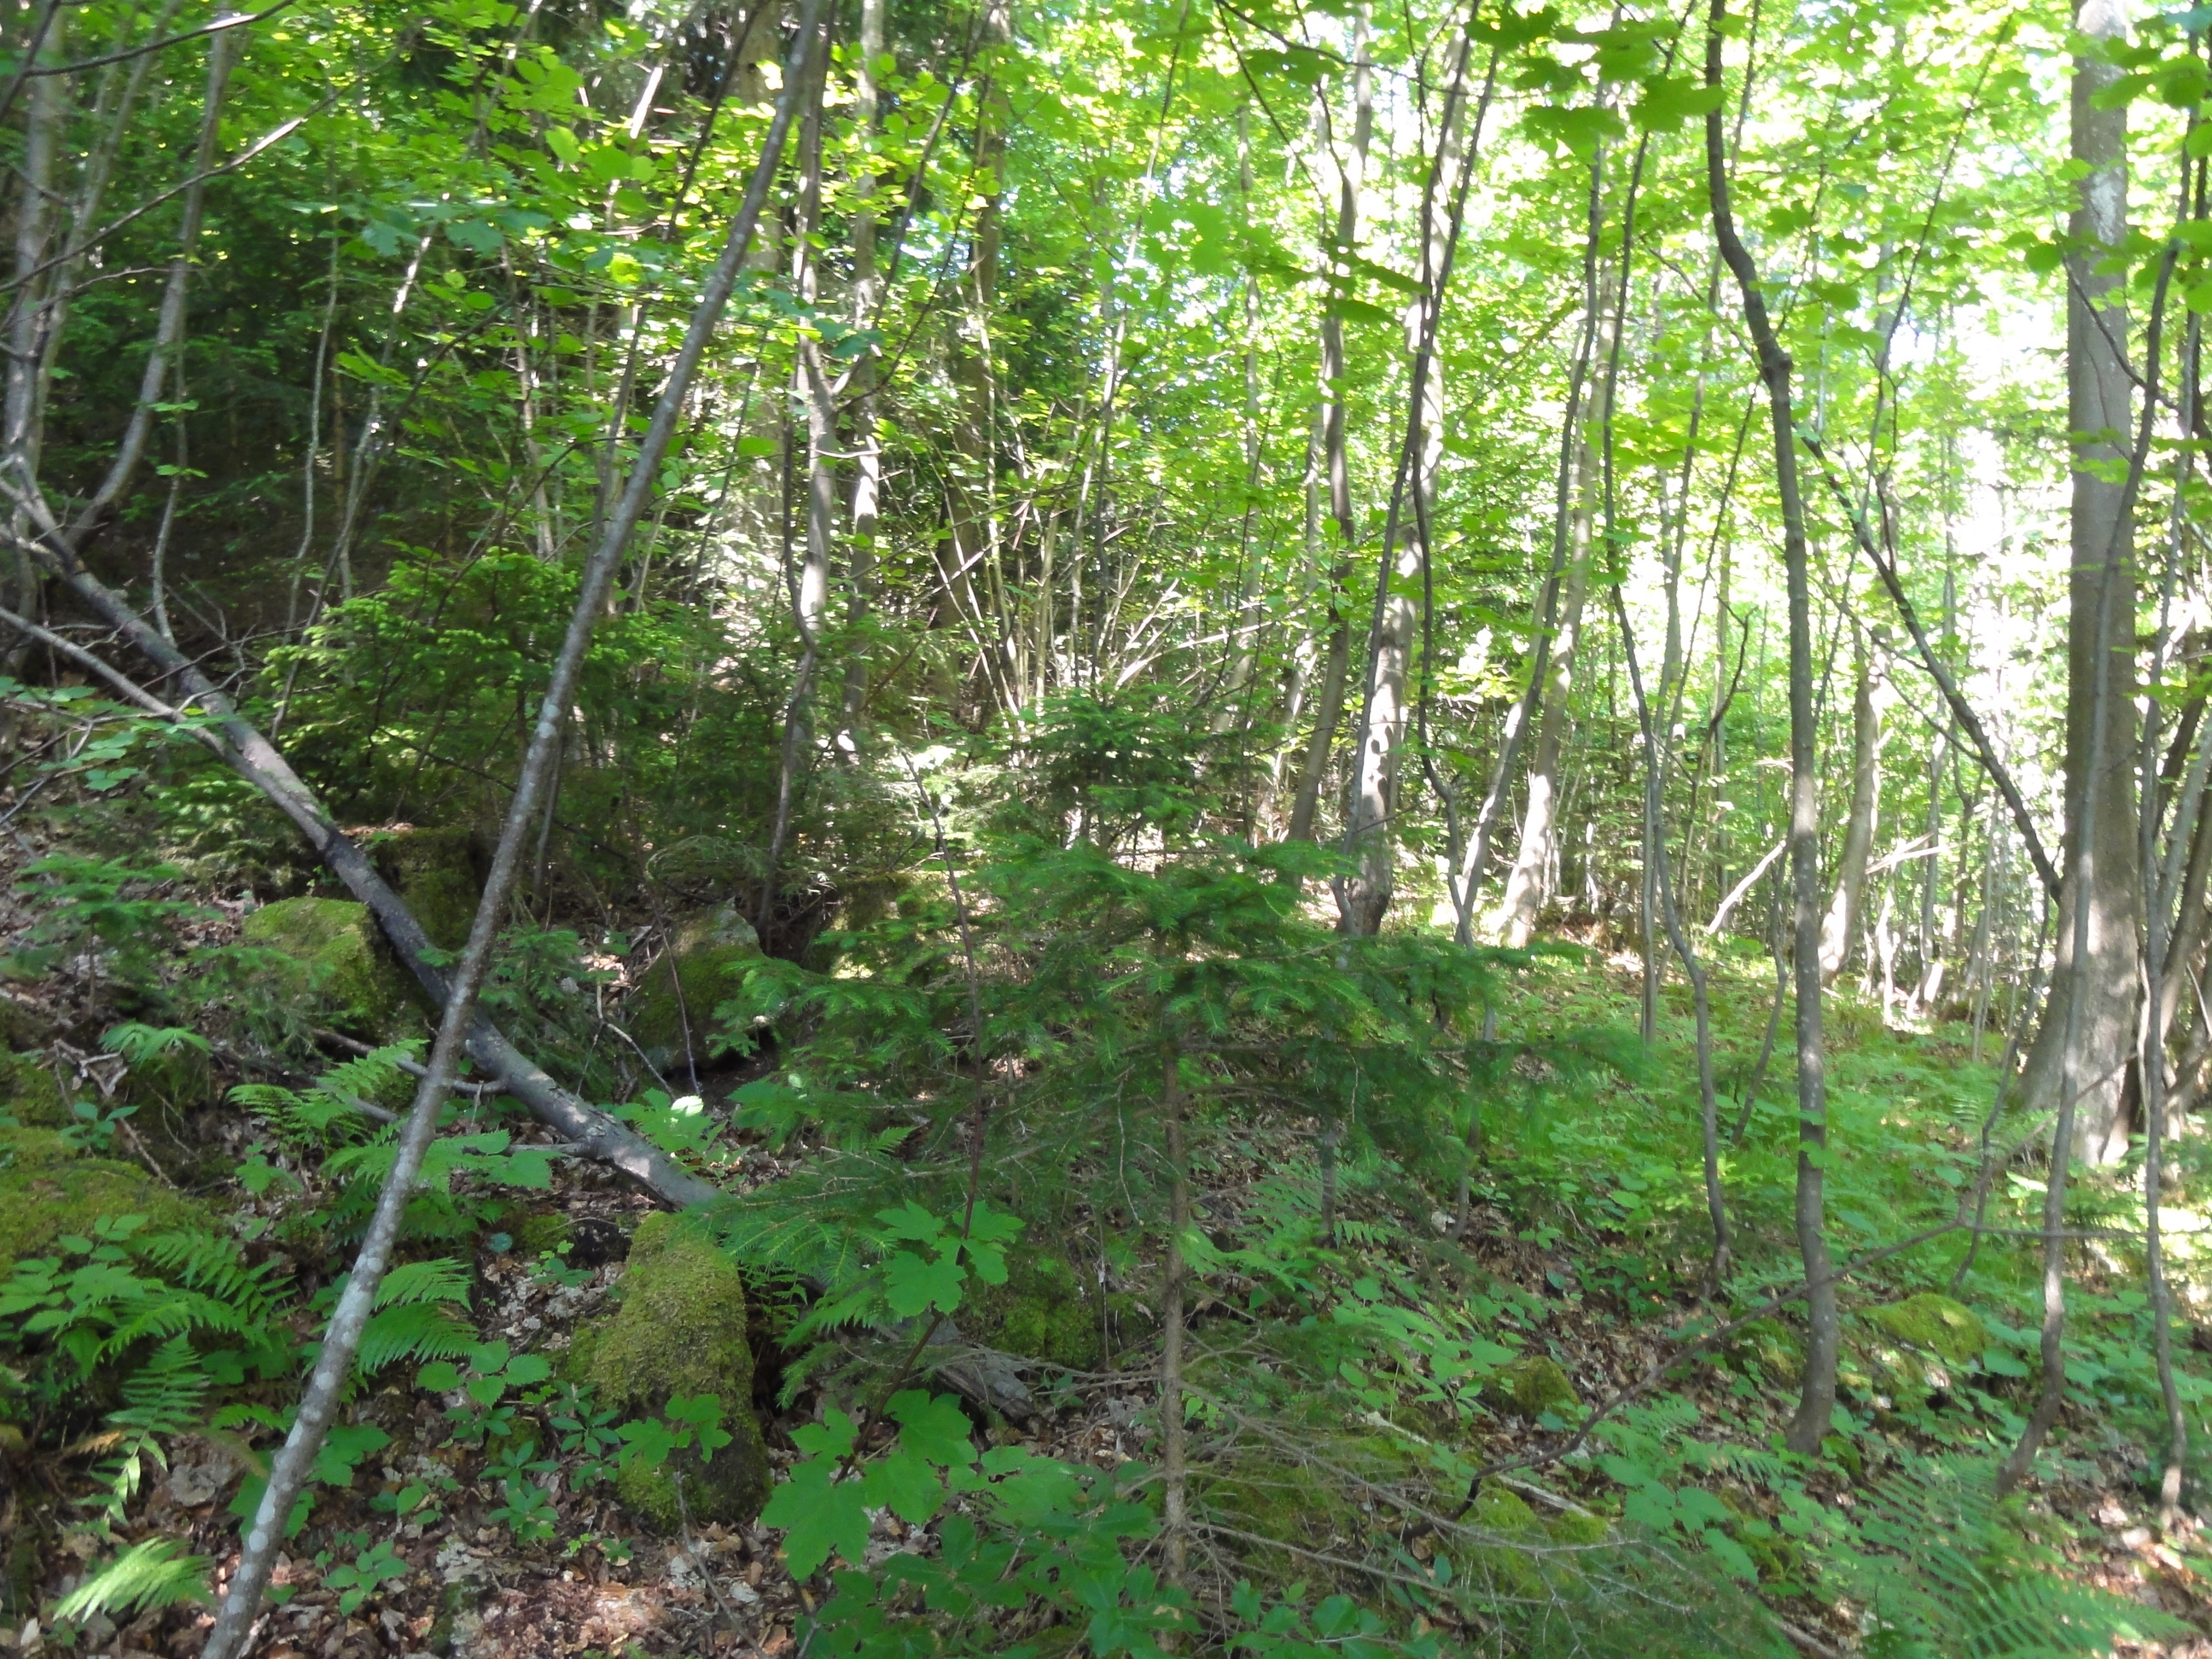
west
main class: Woodland
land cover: Spruce dominated mixed woodland
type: mountainous beech forest
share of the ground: > 75 %
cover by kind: broadleaved forest trees 70 %, coniferous forest trees 30 %
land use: Forestry
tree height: > 5 m
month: June
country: SI
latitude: 46.2767
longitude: 14.8637
